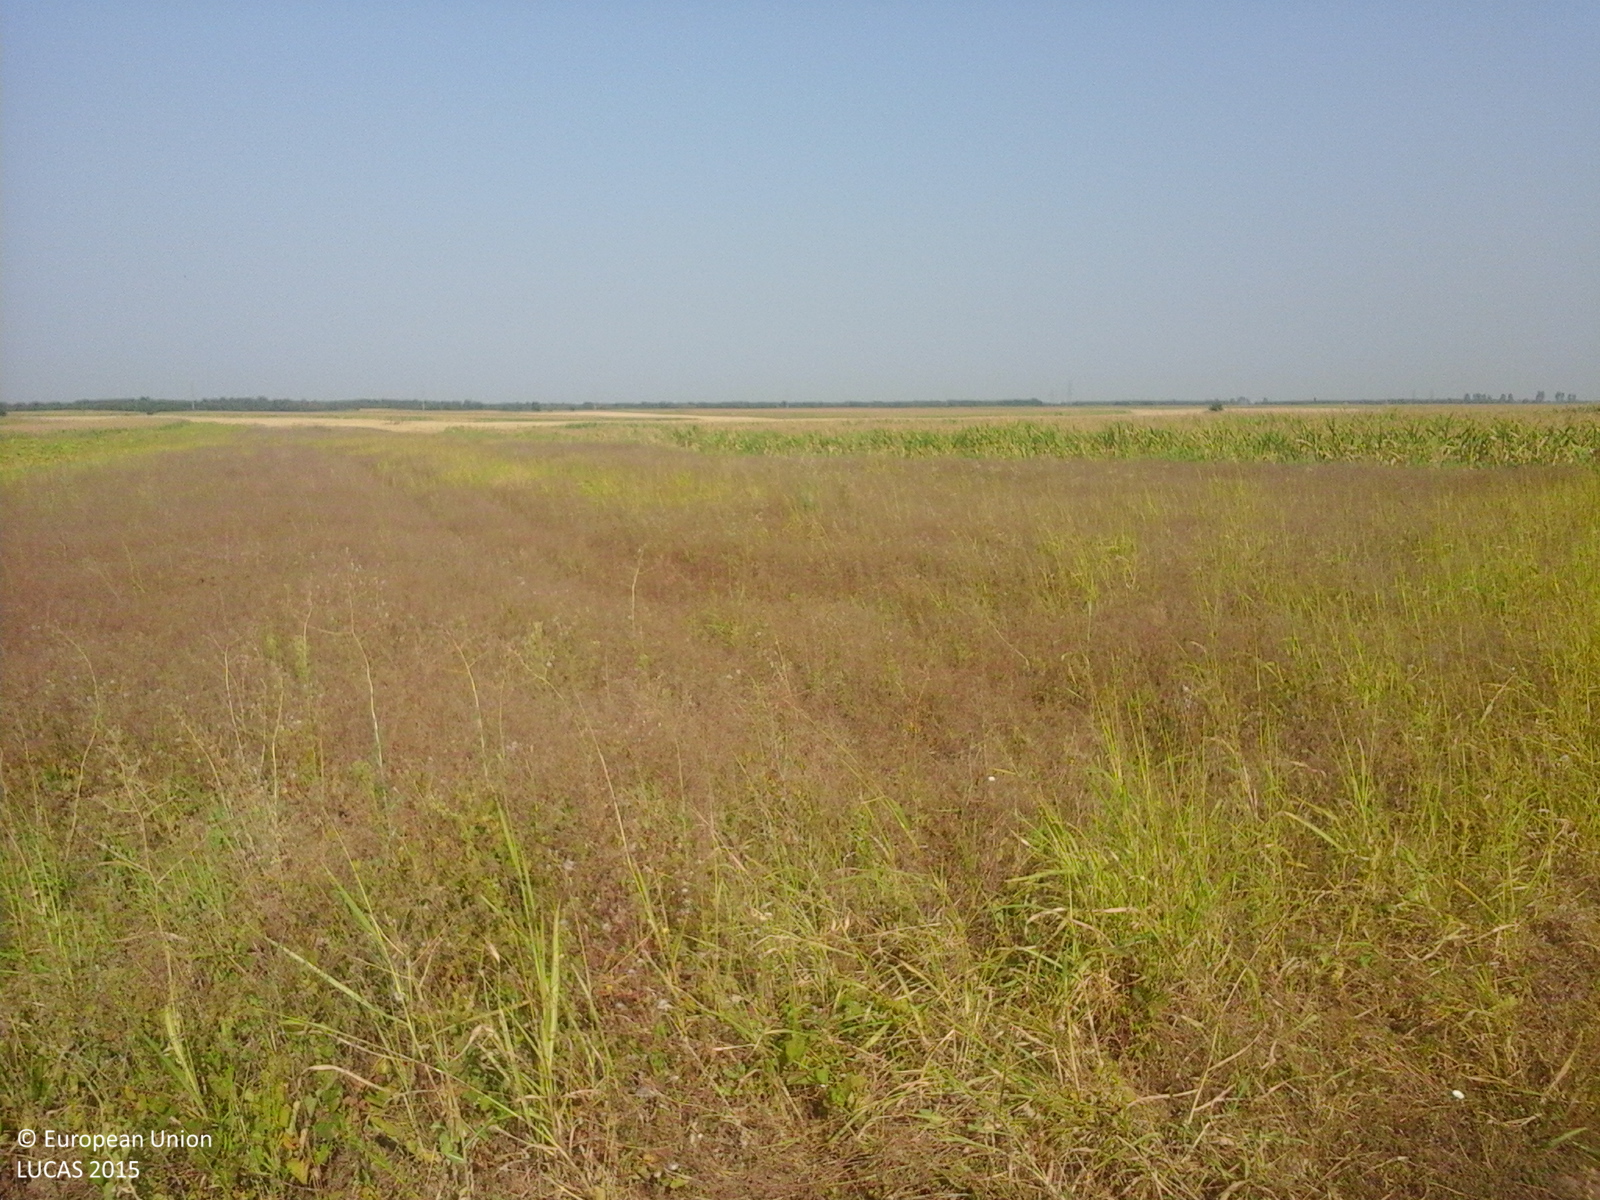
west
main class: Cropland
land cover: Common wheat
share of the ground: > 75 %
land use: Agriculture (excluding fallow land and kitchen gardens)
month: August
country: RO
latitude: 45.7119
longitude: 27.5637
